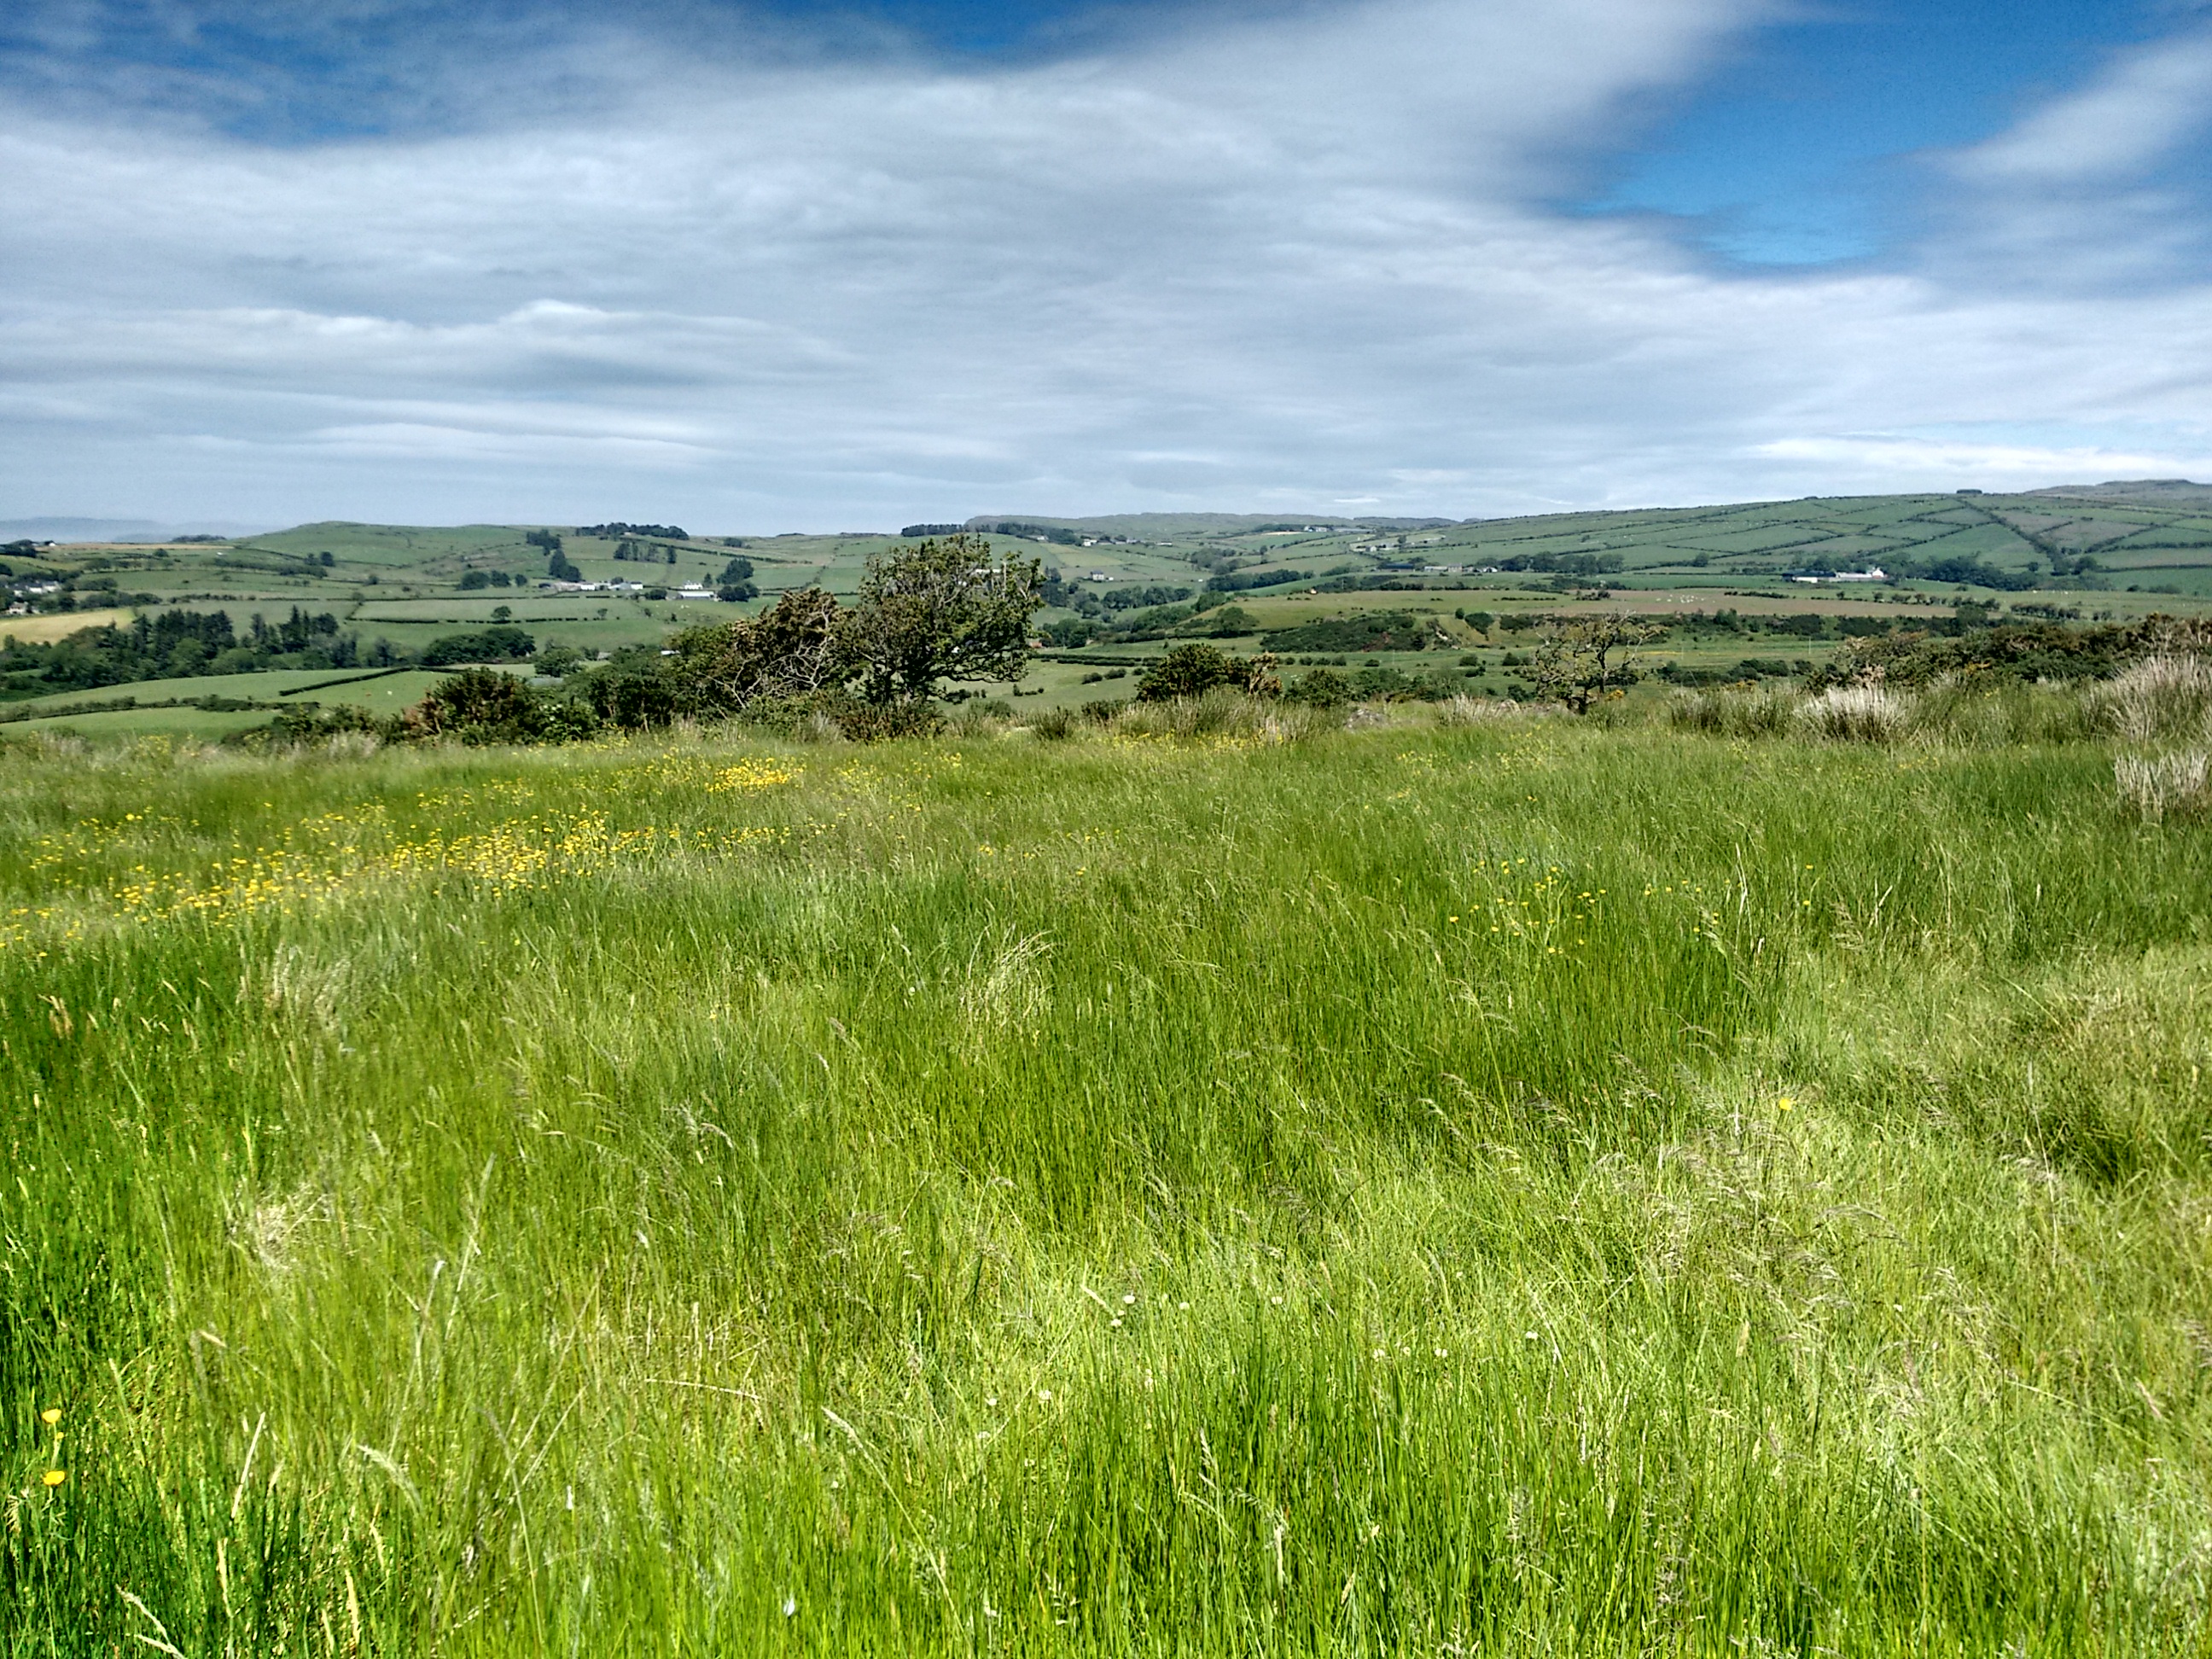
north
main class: Grassland
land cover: Grassland without tree/shrub cover
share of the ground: > 75 %
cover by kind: herbaceous plants 100 %
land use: Agriculture (excluding fallow land and kitchen gardens)
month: June
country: GB
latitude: 55.1873
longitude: -6.1801
